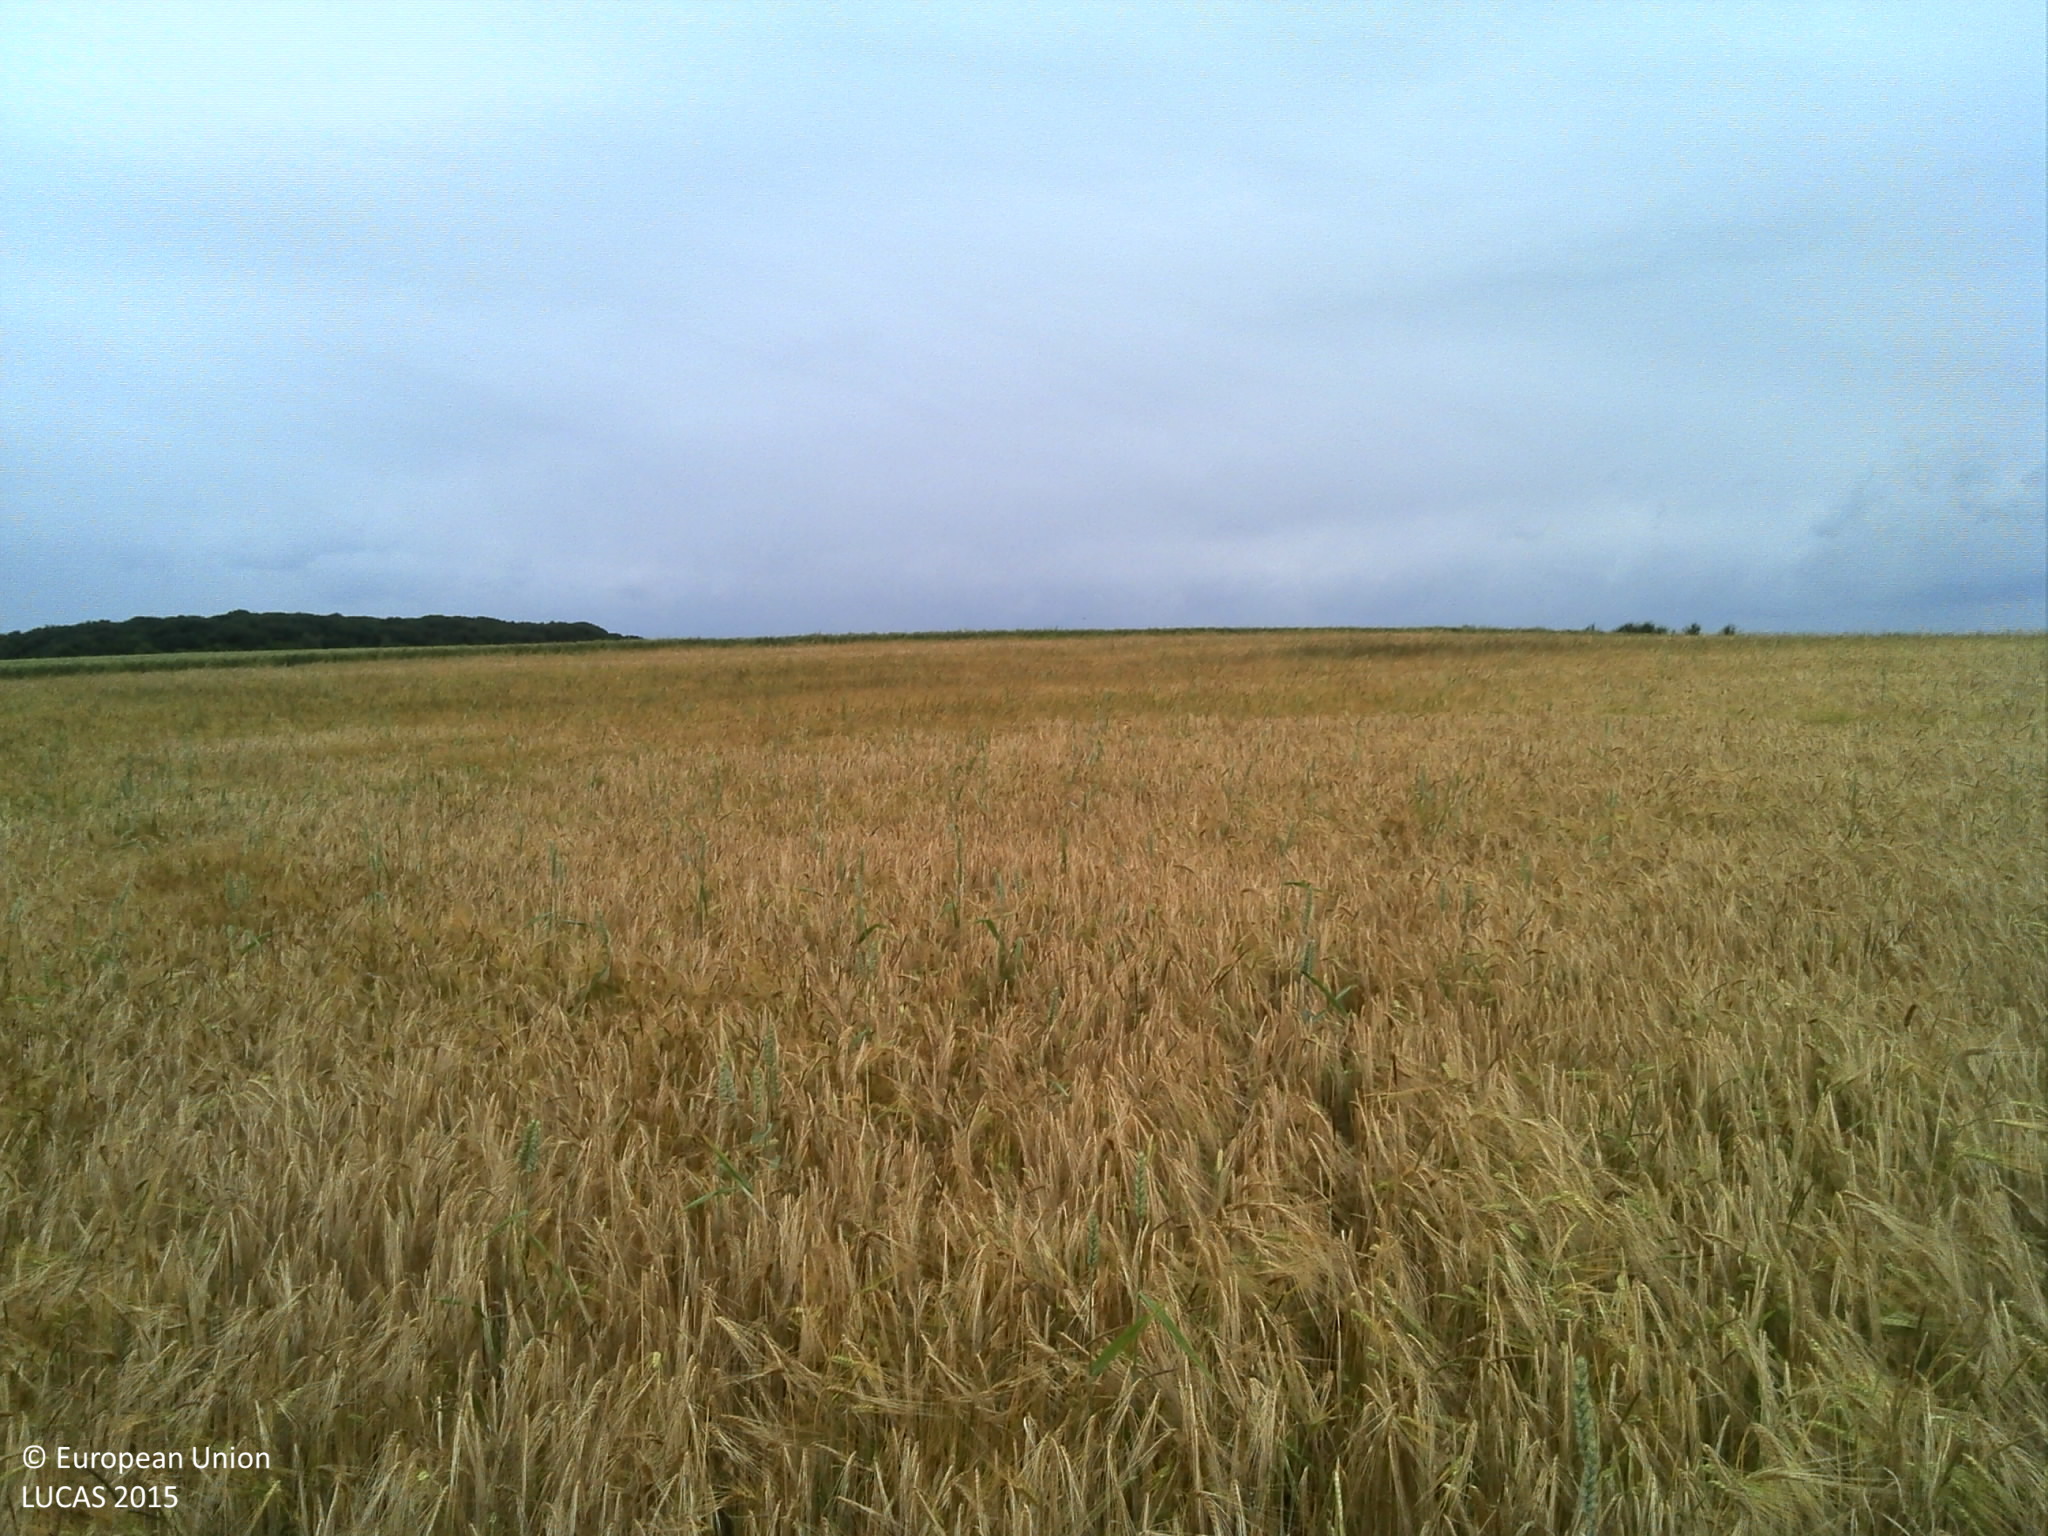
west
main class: Cropland
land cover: Barley
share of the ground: > 75 %
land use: Agriculture (excluding fallow land and kitchen gardens)
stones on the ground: < 10 %
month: June
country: FR
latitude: 49.0670
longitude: 6.4550
